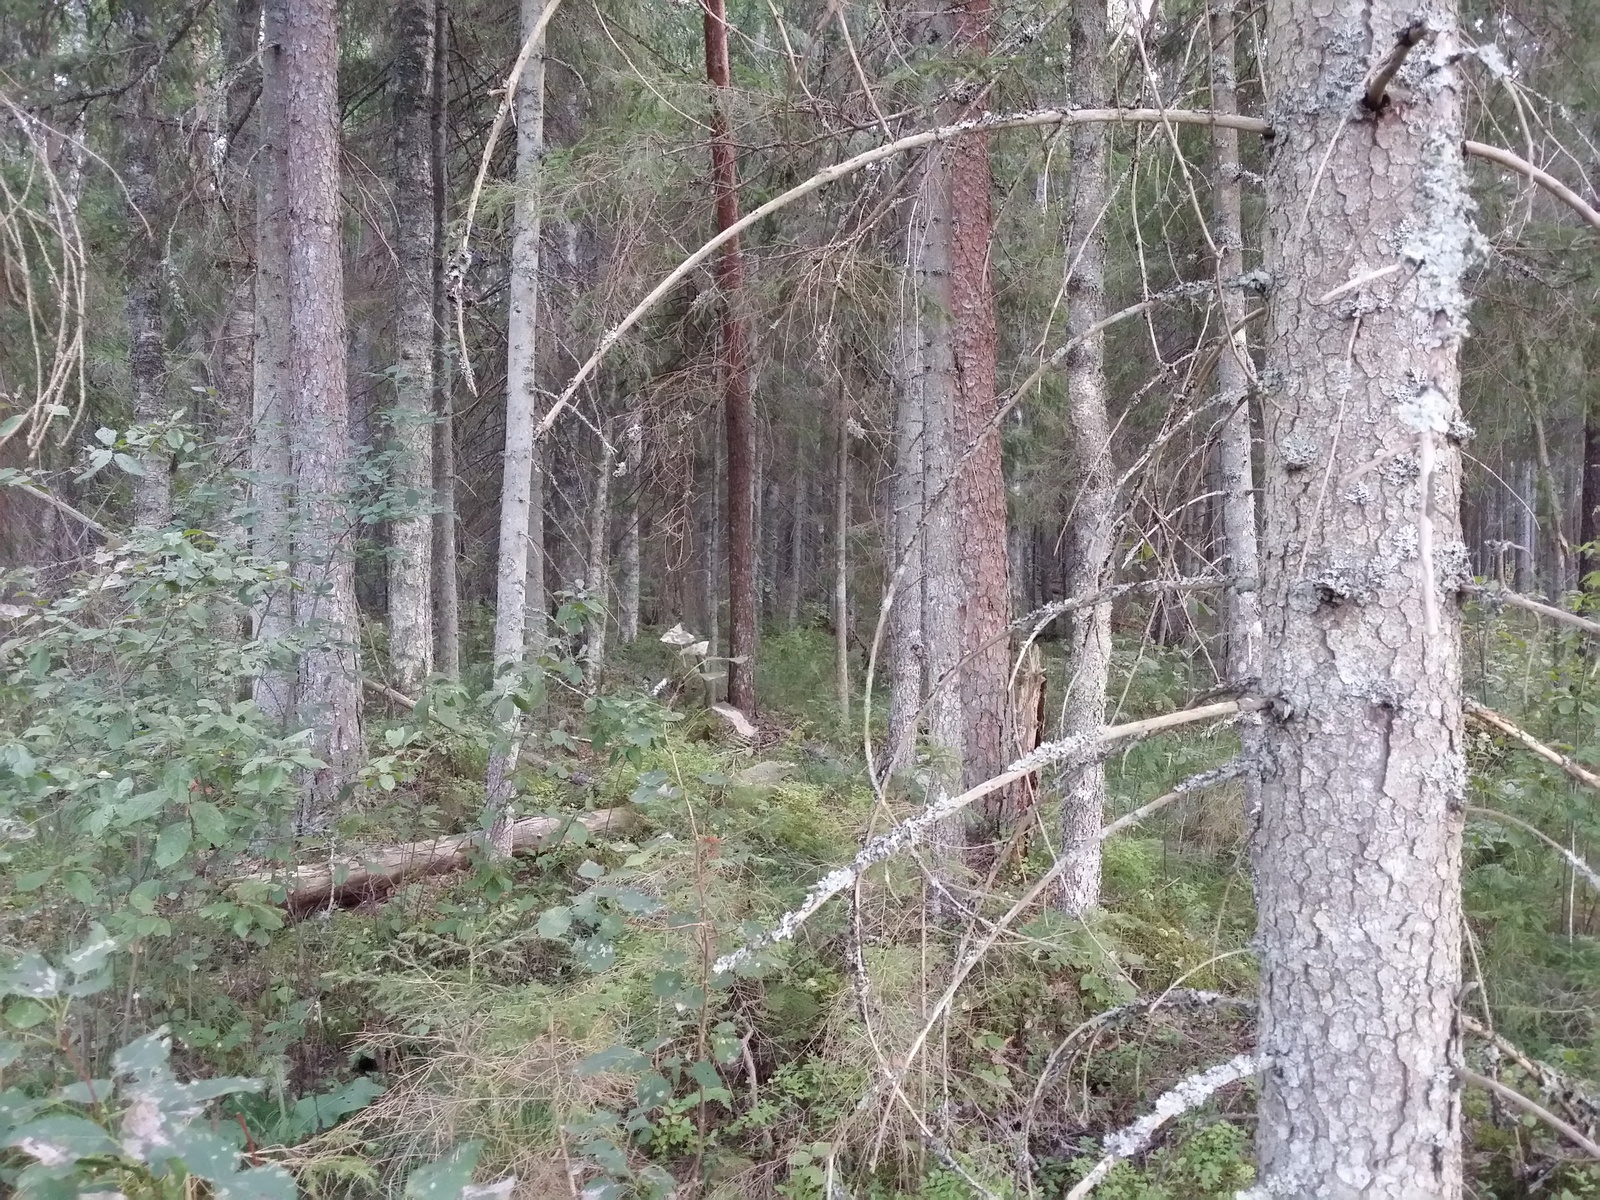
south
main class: Woodland
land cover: Other mixed woodland
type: hemiboreal forest and nemoral coniferous forest and mixed broadleaved-coniferous forest
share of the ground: > 75 %
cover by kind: coniferous forest trees 55 %, broadleaved forest trees 25 %, herbaceous plants 10 %, lichens and mosses 10 %
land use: Forestry
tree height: > 5 m
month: August
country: LV
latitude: 57.5017
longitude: 26.7891
